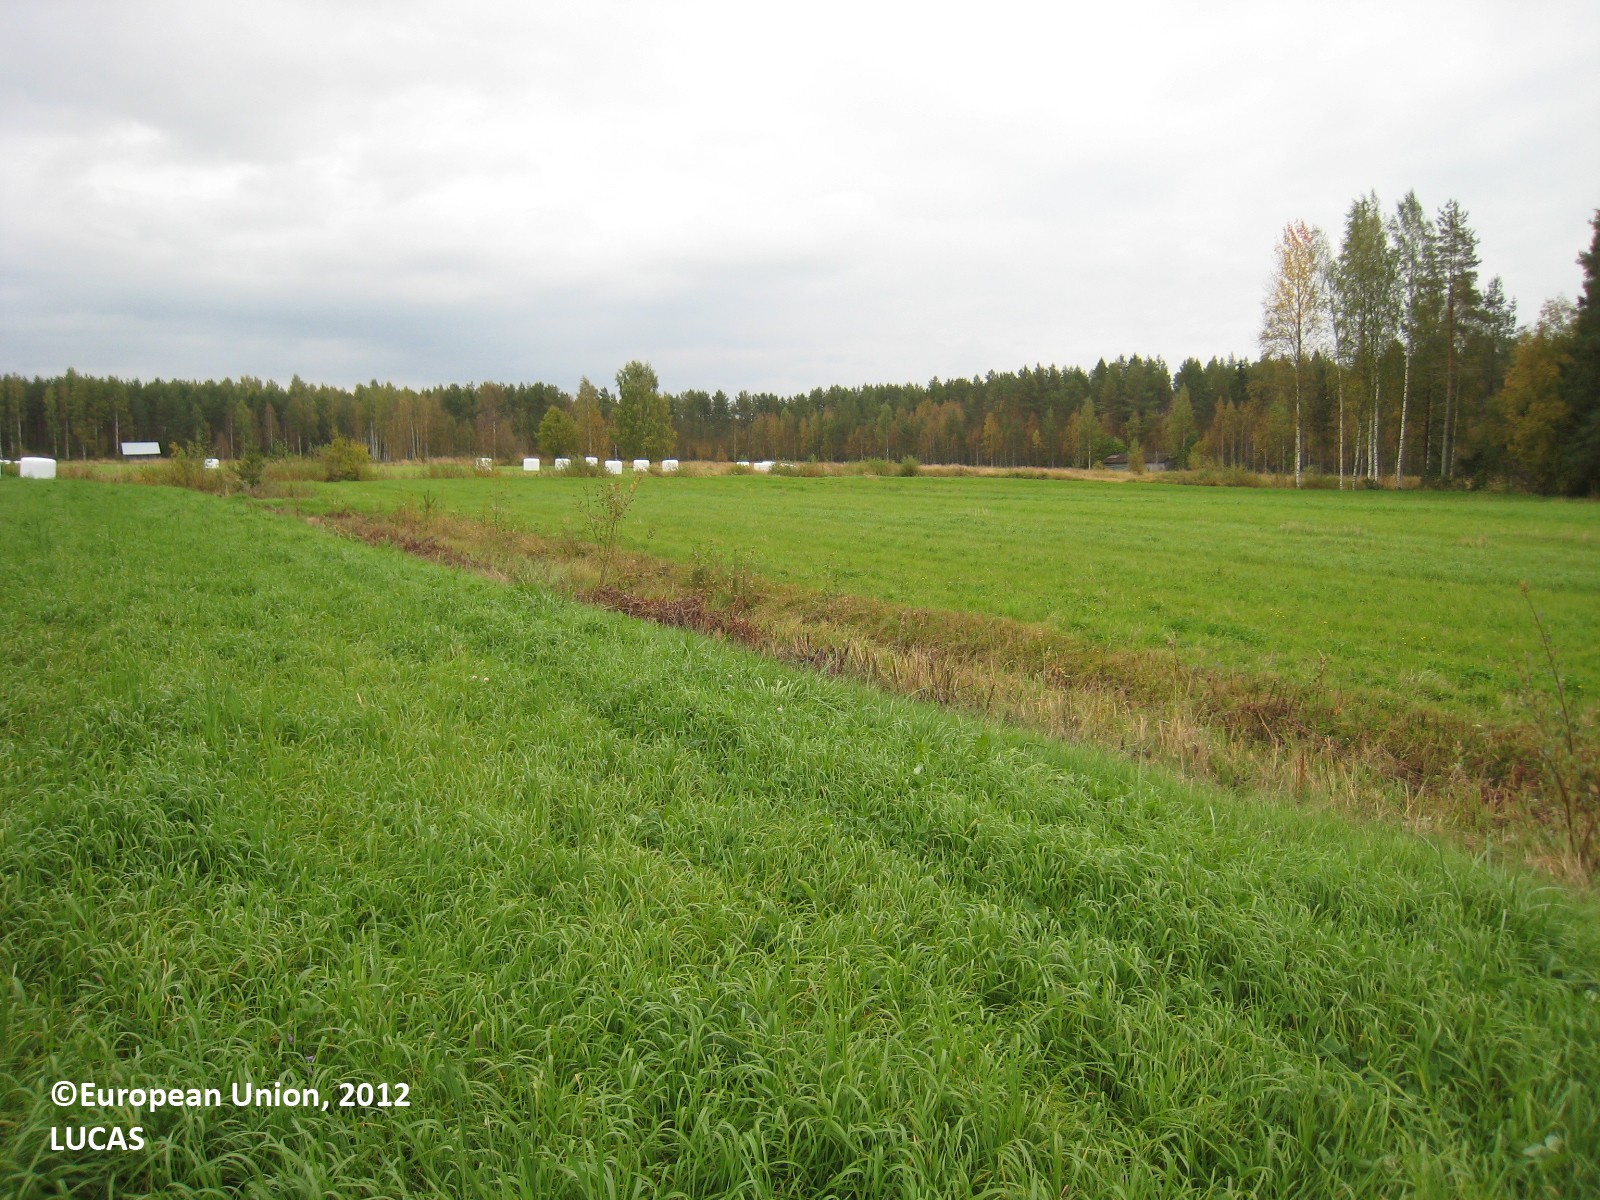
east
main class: Cropland
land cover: Temporary grasslands
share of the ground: > 75 %
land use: Agriculture (excluding fallow land and kitchen gardens)
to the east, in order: Temporary grasslands; Managed hedges; Ditches and canals; Managed hedges; Temporary grasslands; Managed hedges; Ditches and canals; Shruby margins; Temporary grasslands; Ditches and canals; Oats; Shruby margins; Ditches and canals; Shruby margins; Oats; Shruby margins; Ditches and canals; Oats; Shruby margins; Ditches and canals
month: September
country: FI
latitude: 62.7323
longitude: 26.6319
